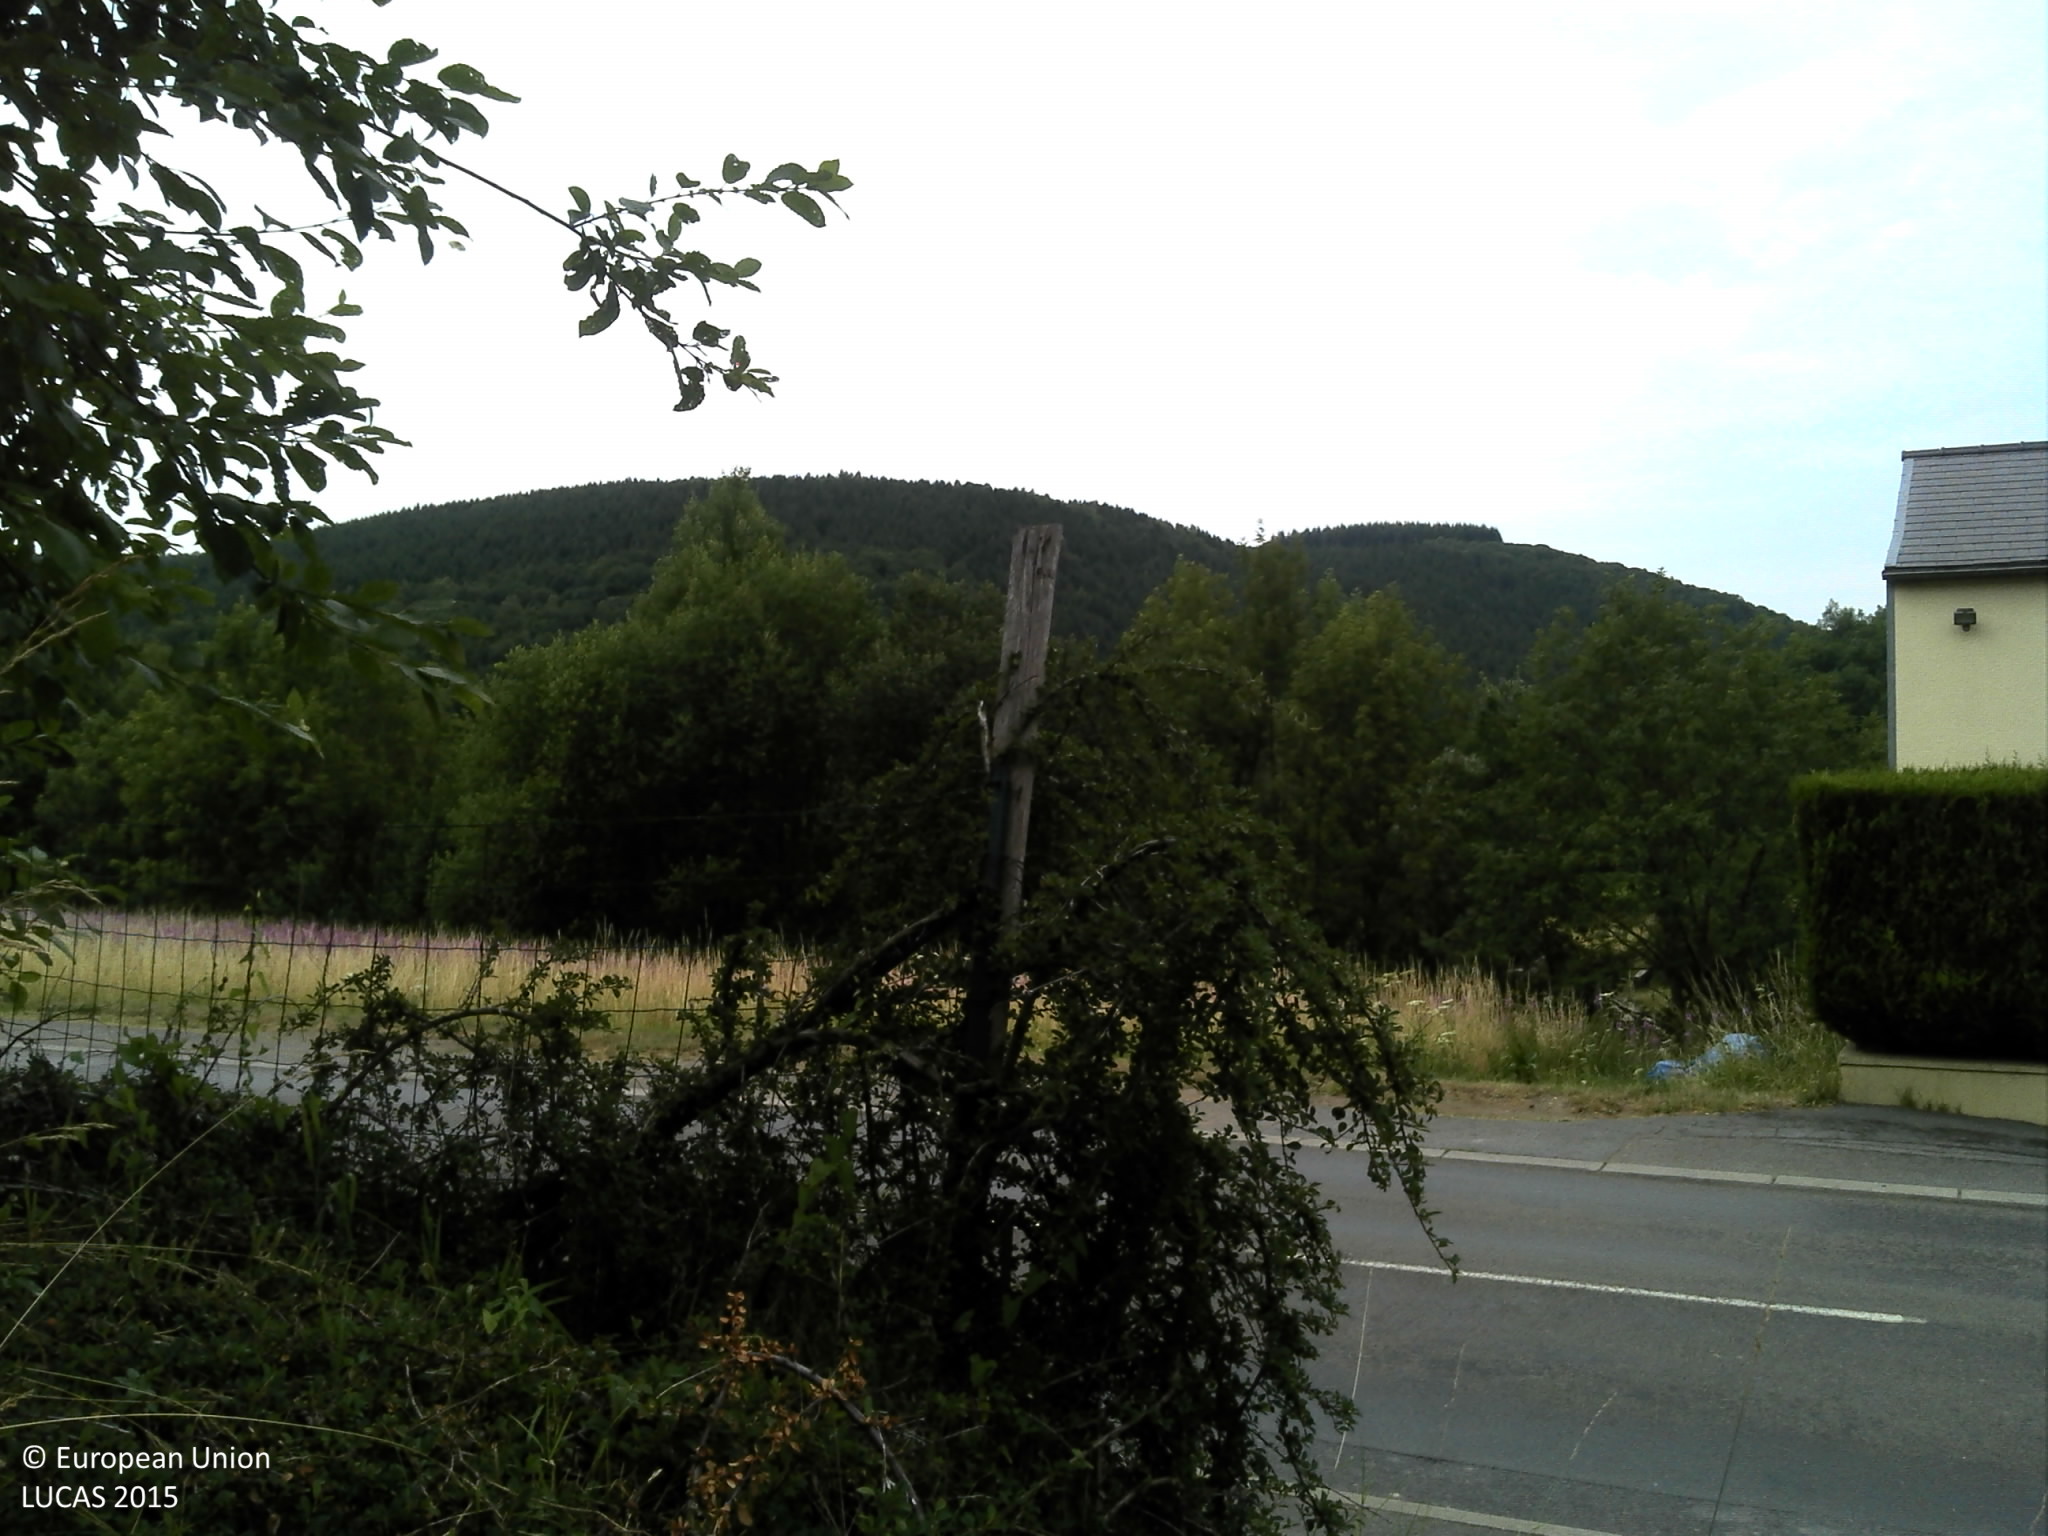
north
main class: Grassland
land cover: Grassland with sparse tree/shrub cover
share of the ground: > 75 %
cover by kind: herbaceous plants 95 %, broadleaved forest trees 5 %
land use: Residential
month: July
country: FR
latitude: 49.8127
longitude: 4.7855
